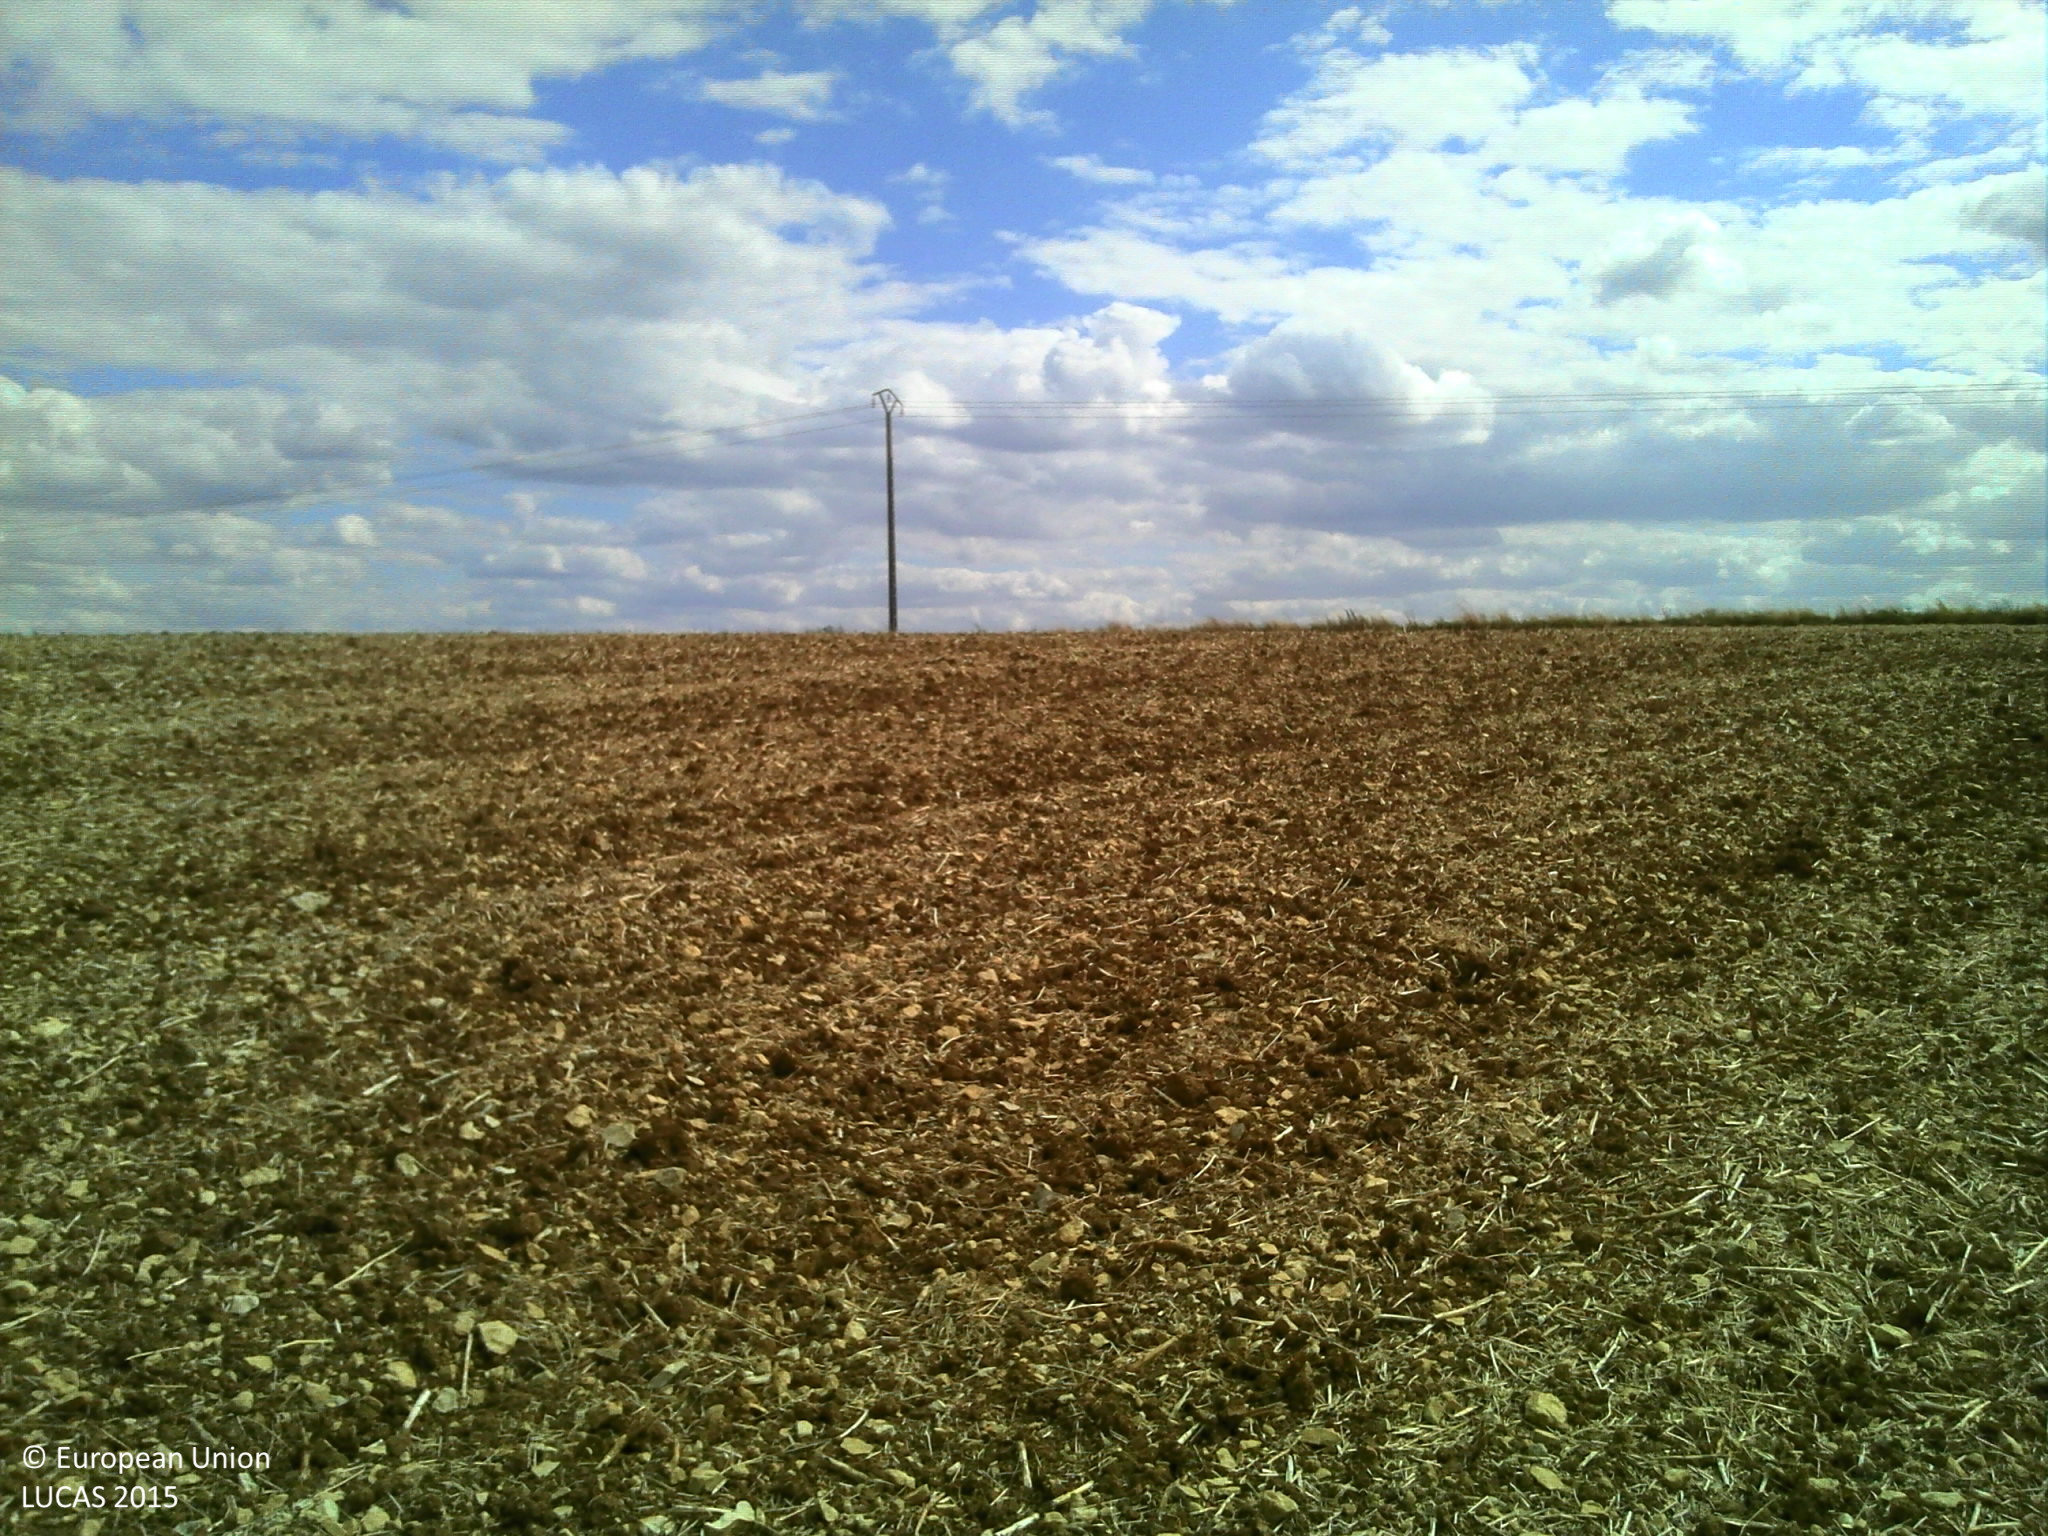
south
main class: Cropland
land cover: Rape and turnip rape
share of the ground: < 10 %
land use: Agriculture (excluding fallow land and kitchen gardens)
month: July
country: FR
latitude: 49.2031
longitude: 5.2632
